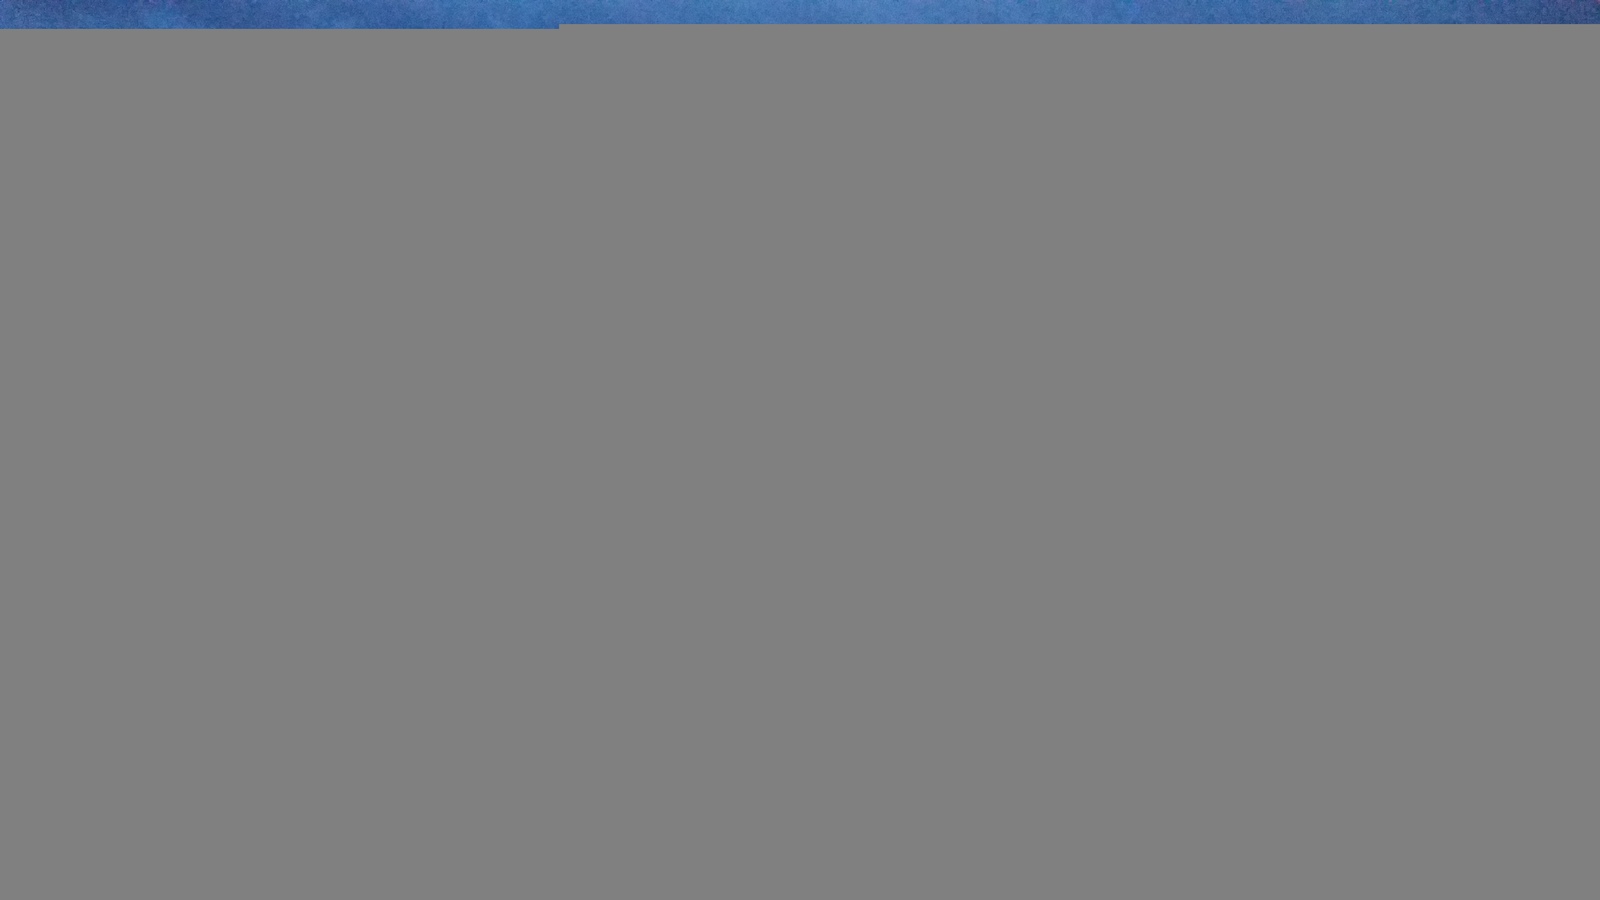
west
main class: Grassland
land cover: Grassland without tree/shrub cover
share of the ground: > 75 %
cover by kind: herbaceous plants 100 %
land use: Agriculture (excluding fallow land and kitchen gardens)
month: September
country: RO
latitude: 47.9366
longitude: 23.6391
